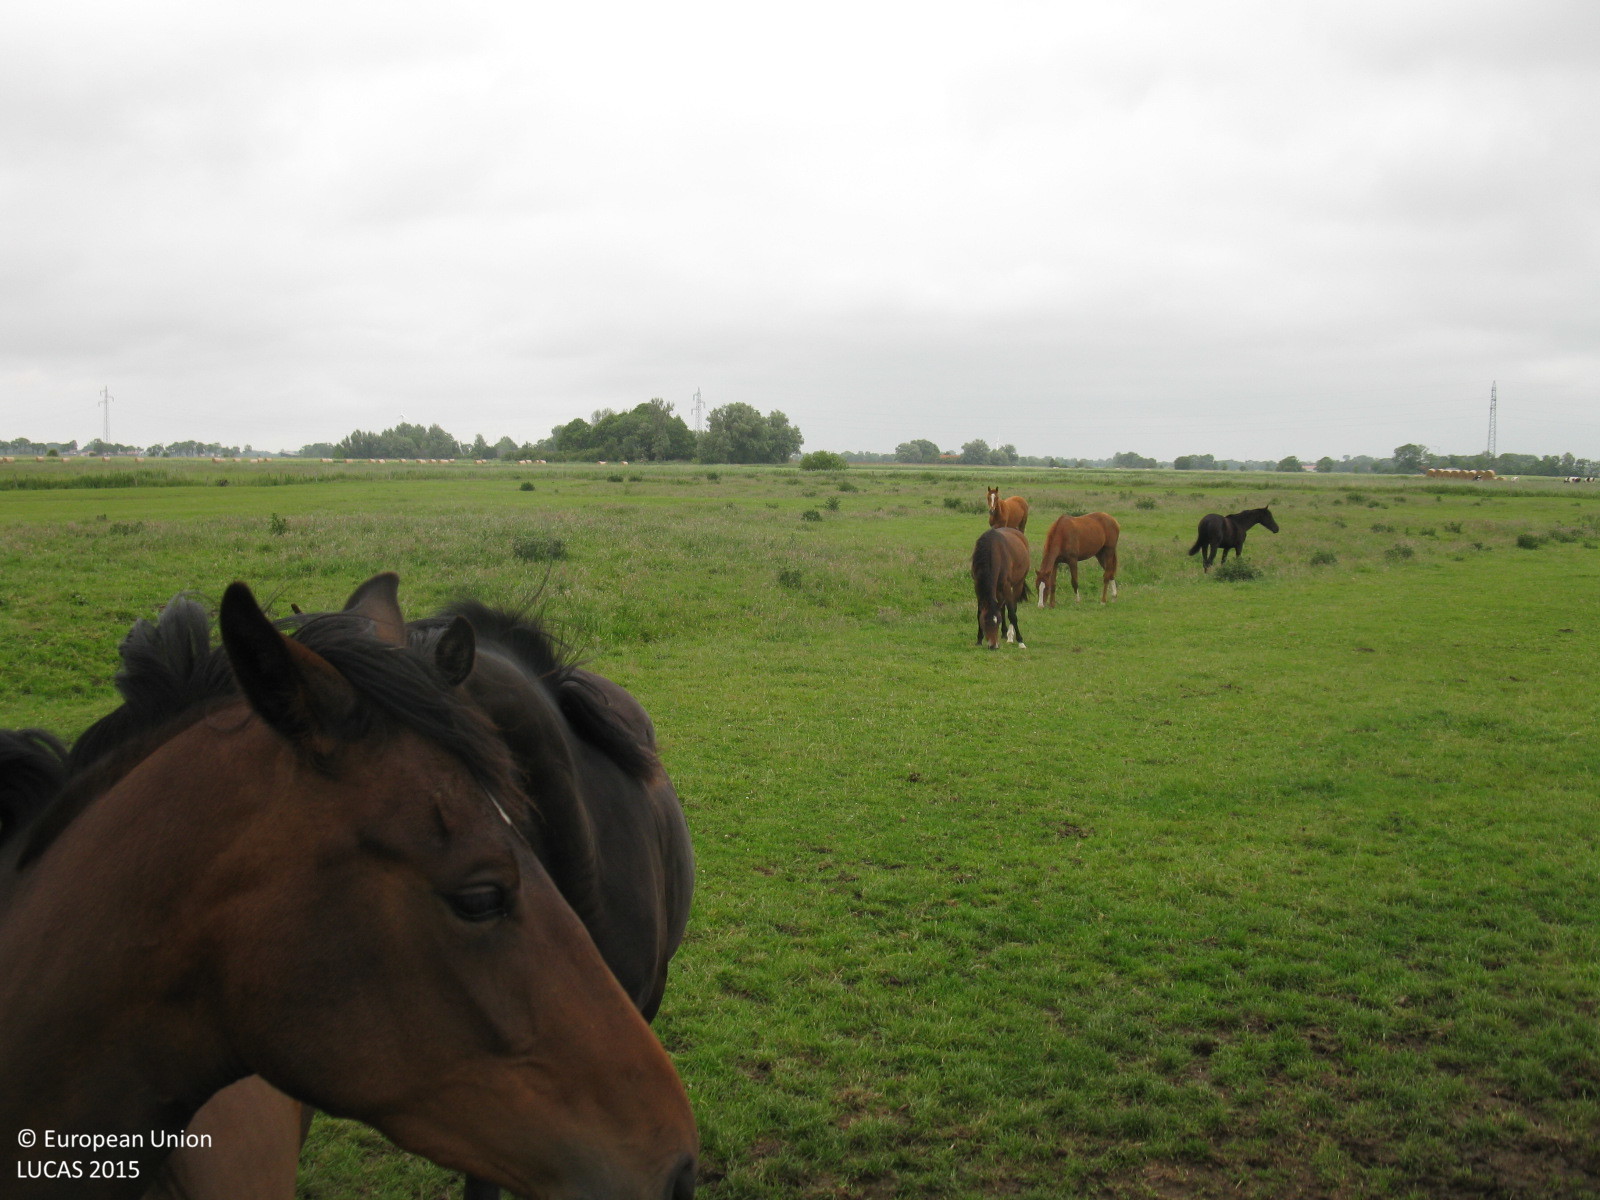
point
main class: Grassland
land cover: Grassland without tree/shrub cover
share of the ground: > 75 %
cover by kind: herbaceous plants 100 %
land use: Agriculture (excluding fallow land and kitchen gardens)
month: June
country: DE
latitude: 53.6534
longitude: 7.8977
